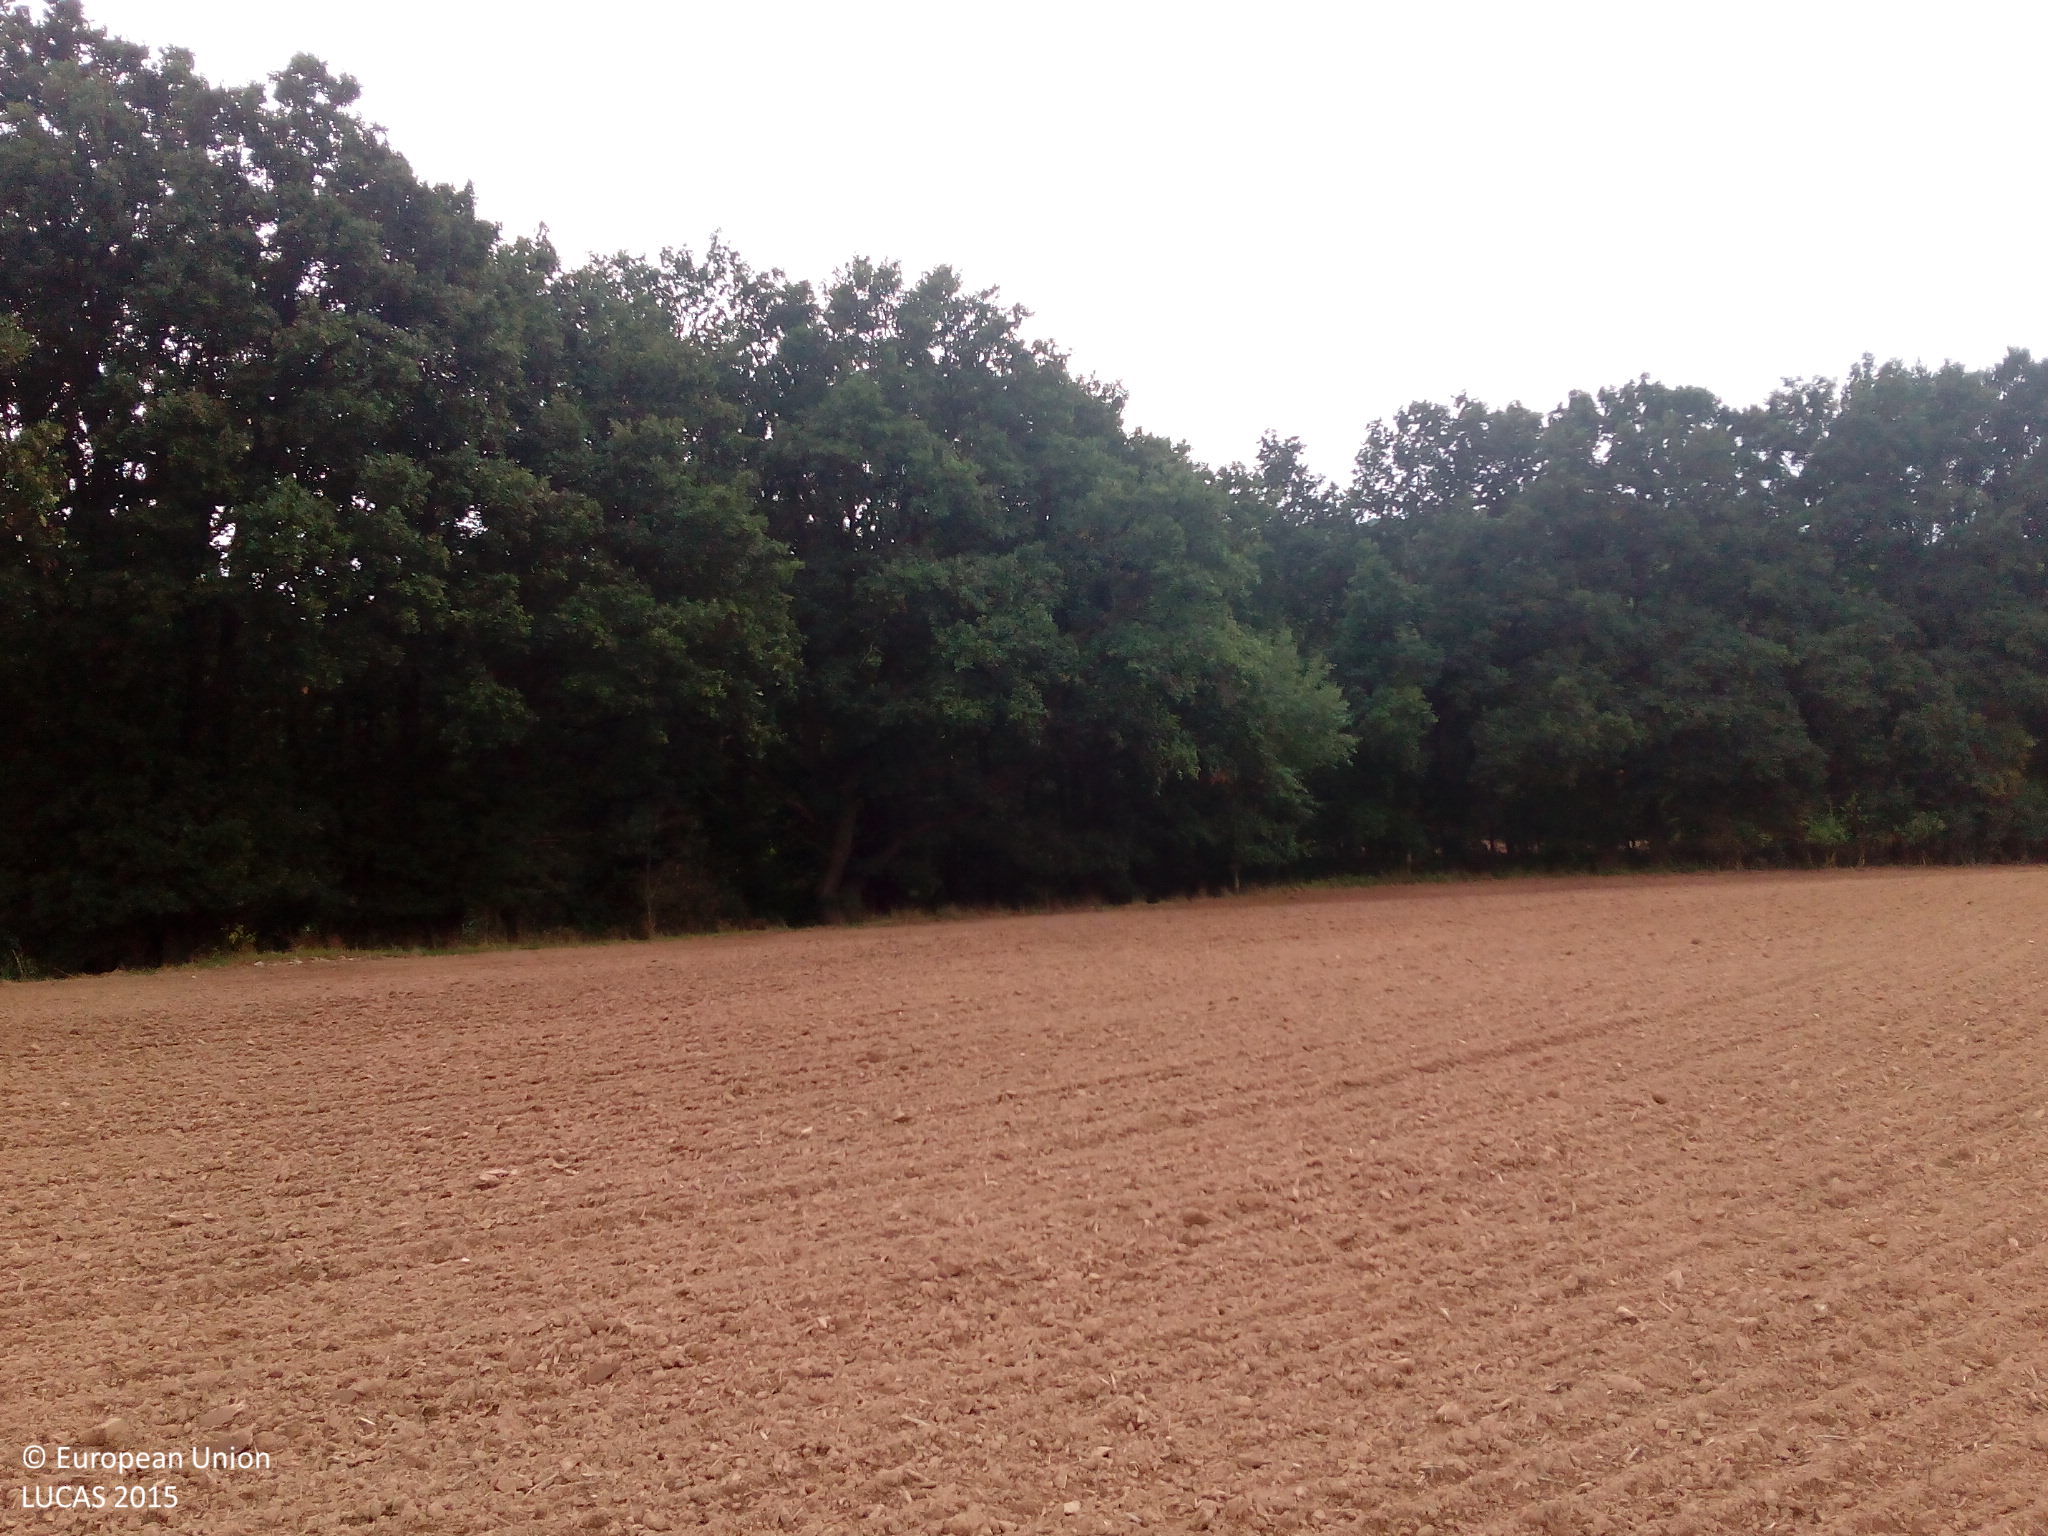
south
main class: Cropland
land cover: Rape and turnip rape
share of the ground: < 10 %
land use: Agriculture (excluding fallow land and kitchen gardens)
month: September
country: DE
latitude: 51.4917
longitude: 11.0799
